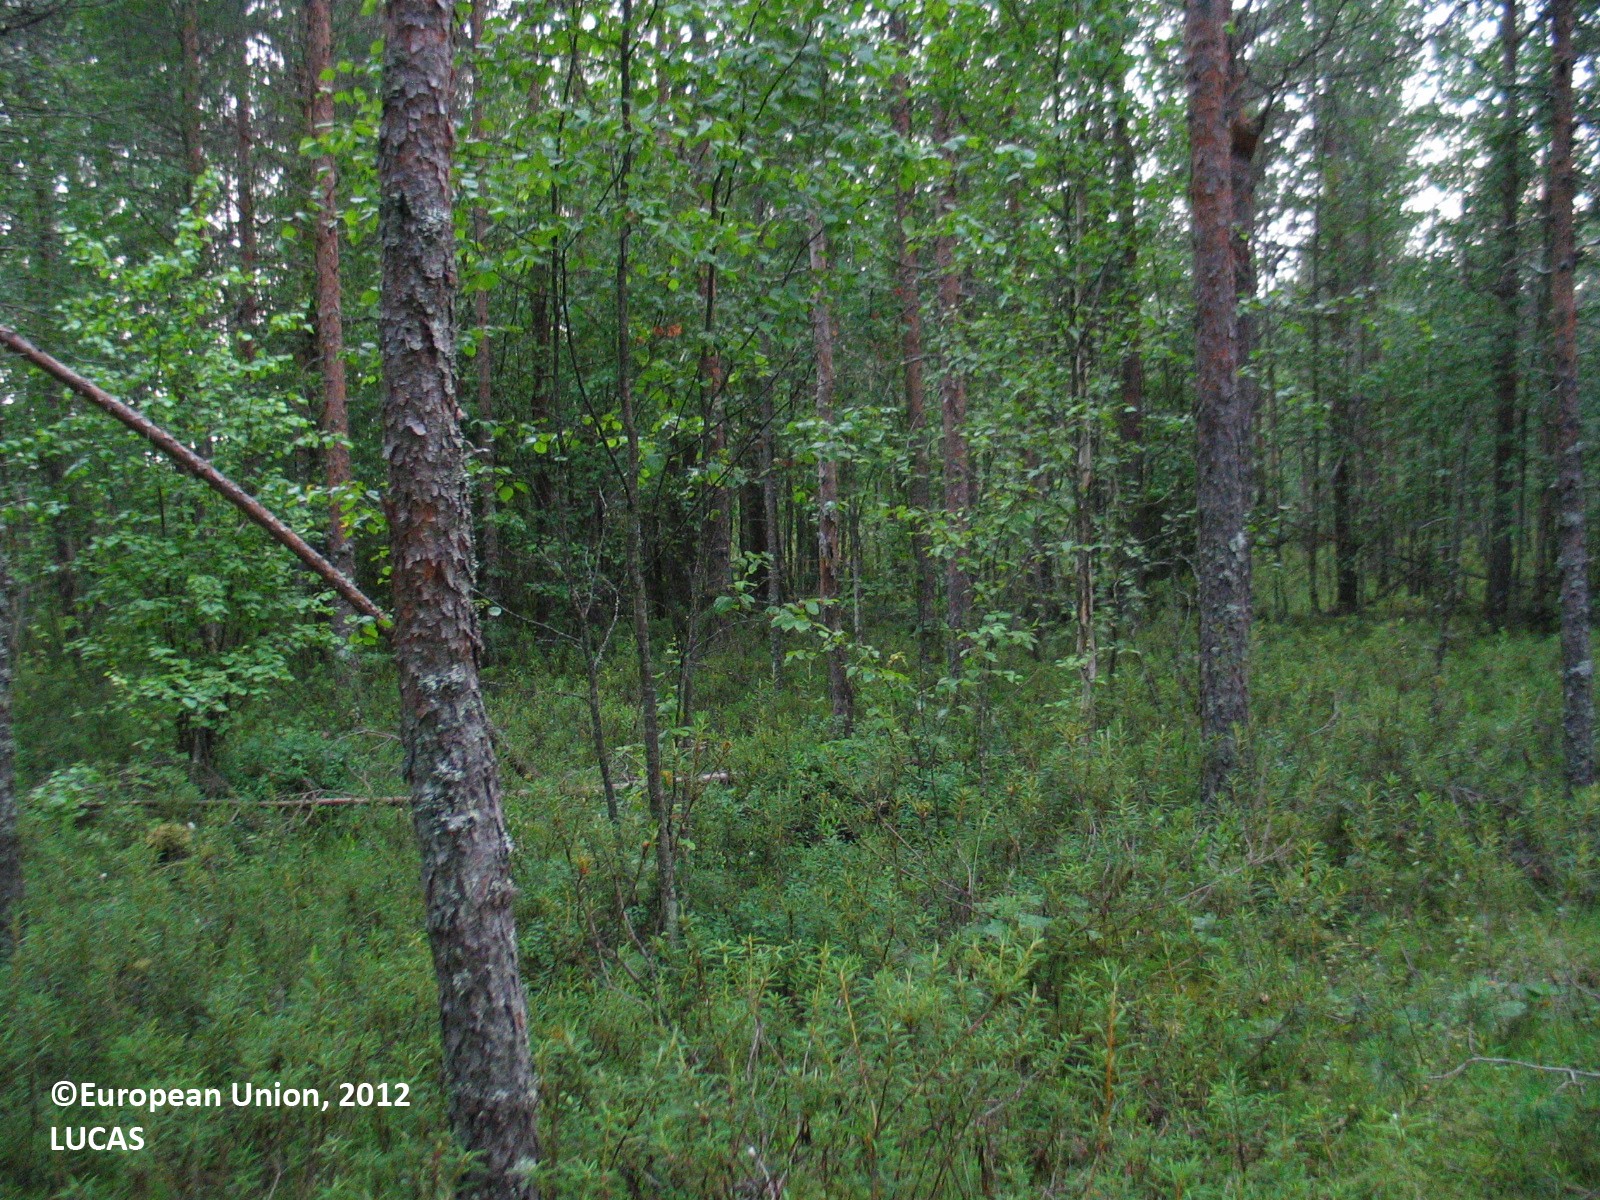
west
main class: Woodland
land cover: Pine dominated coniferous woodland
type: mire and swamp forests
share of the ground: 50 - 75 %
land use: Forestry
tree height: > 5 m
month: July
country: FI
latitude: 64.7167
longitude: 26.4578
